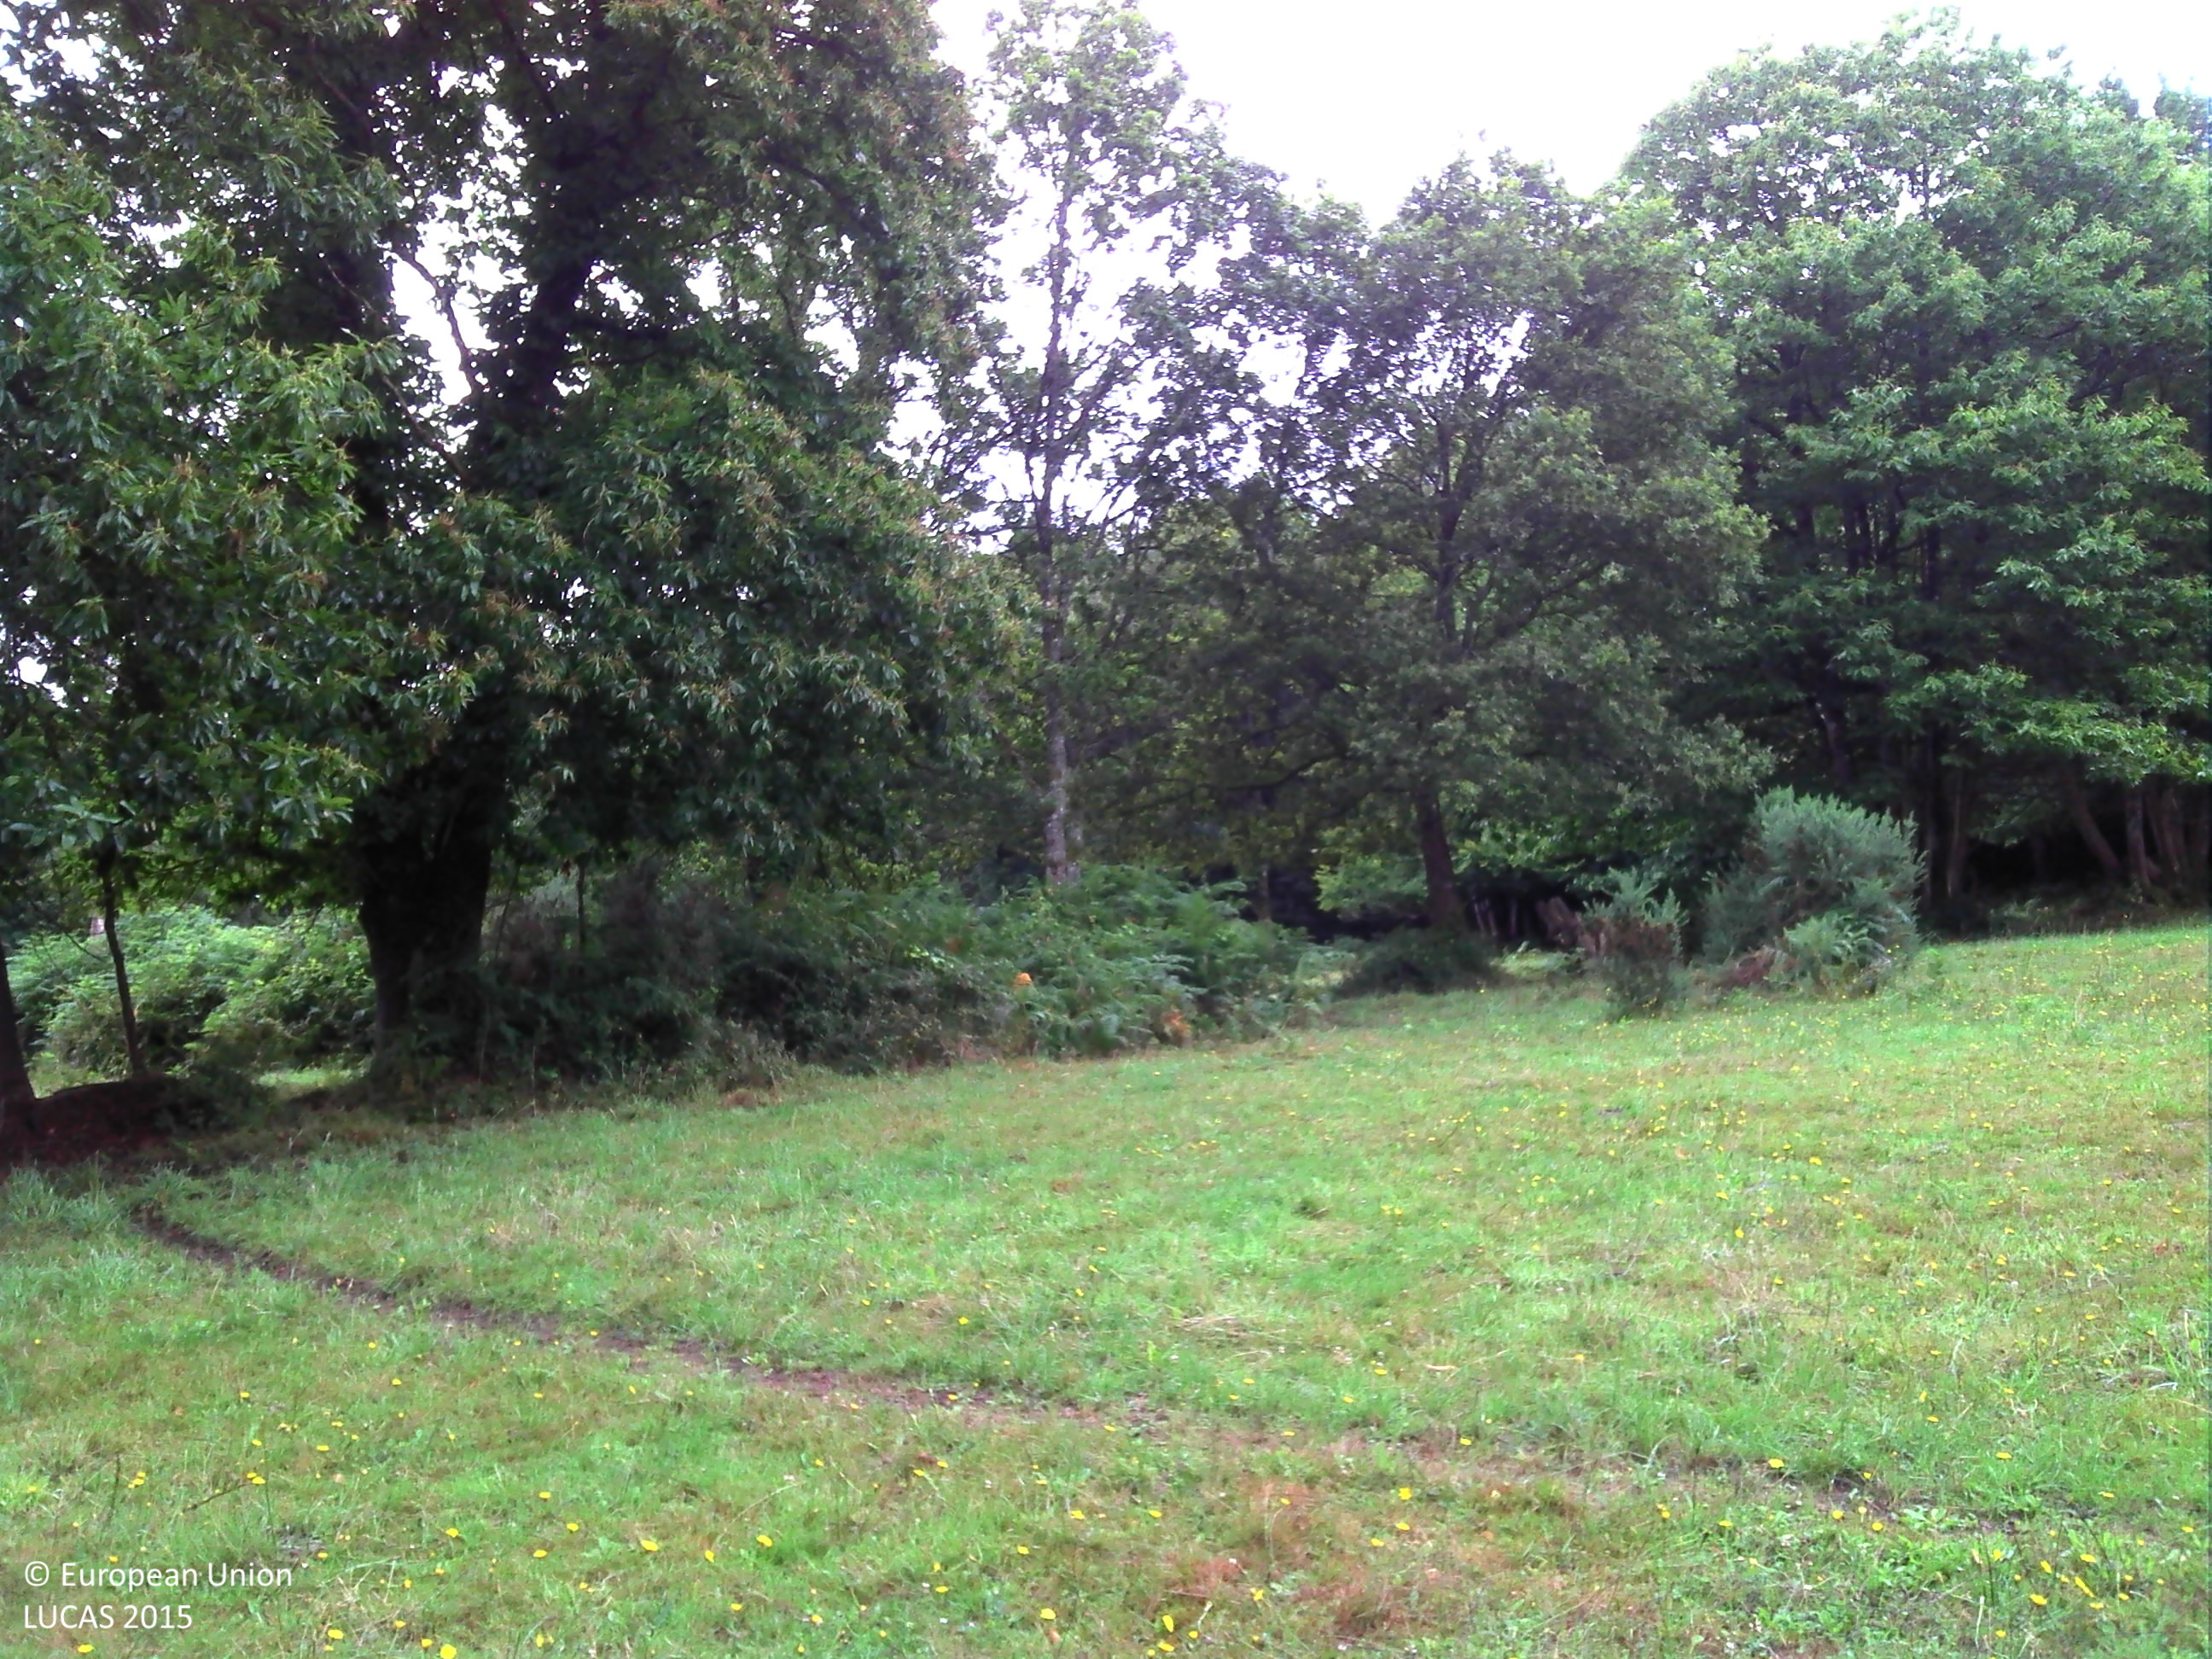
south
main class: Grassland
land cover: Grassland without tree/shrub cover
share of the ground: > 75 %
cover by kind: herbaceous plants 70 %, consolidated bare surface 20 %, shrubs 5 %, unconsolidated bare surface 5 %
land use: Agriculture (excluding fallow land and kitchen gardens)
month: July
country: FR
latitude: 48.0237
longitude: -3.5262
